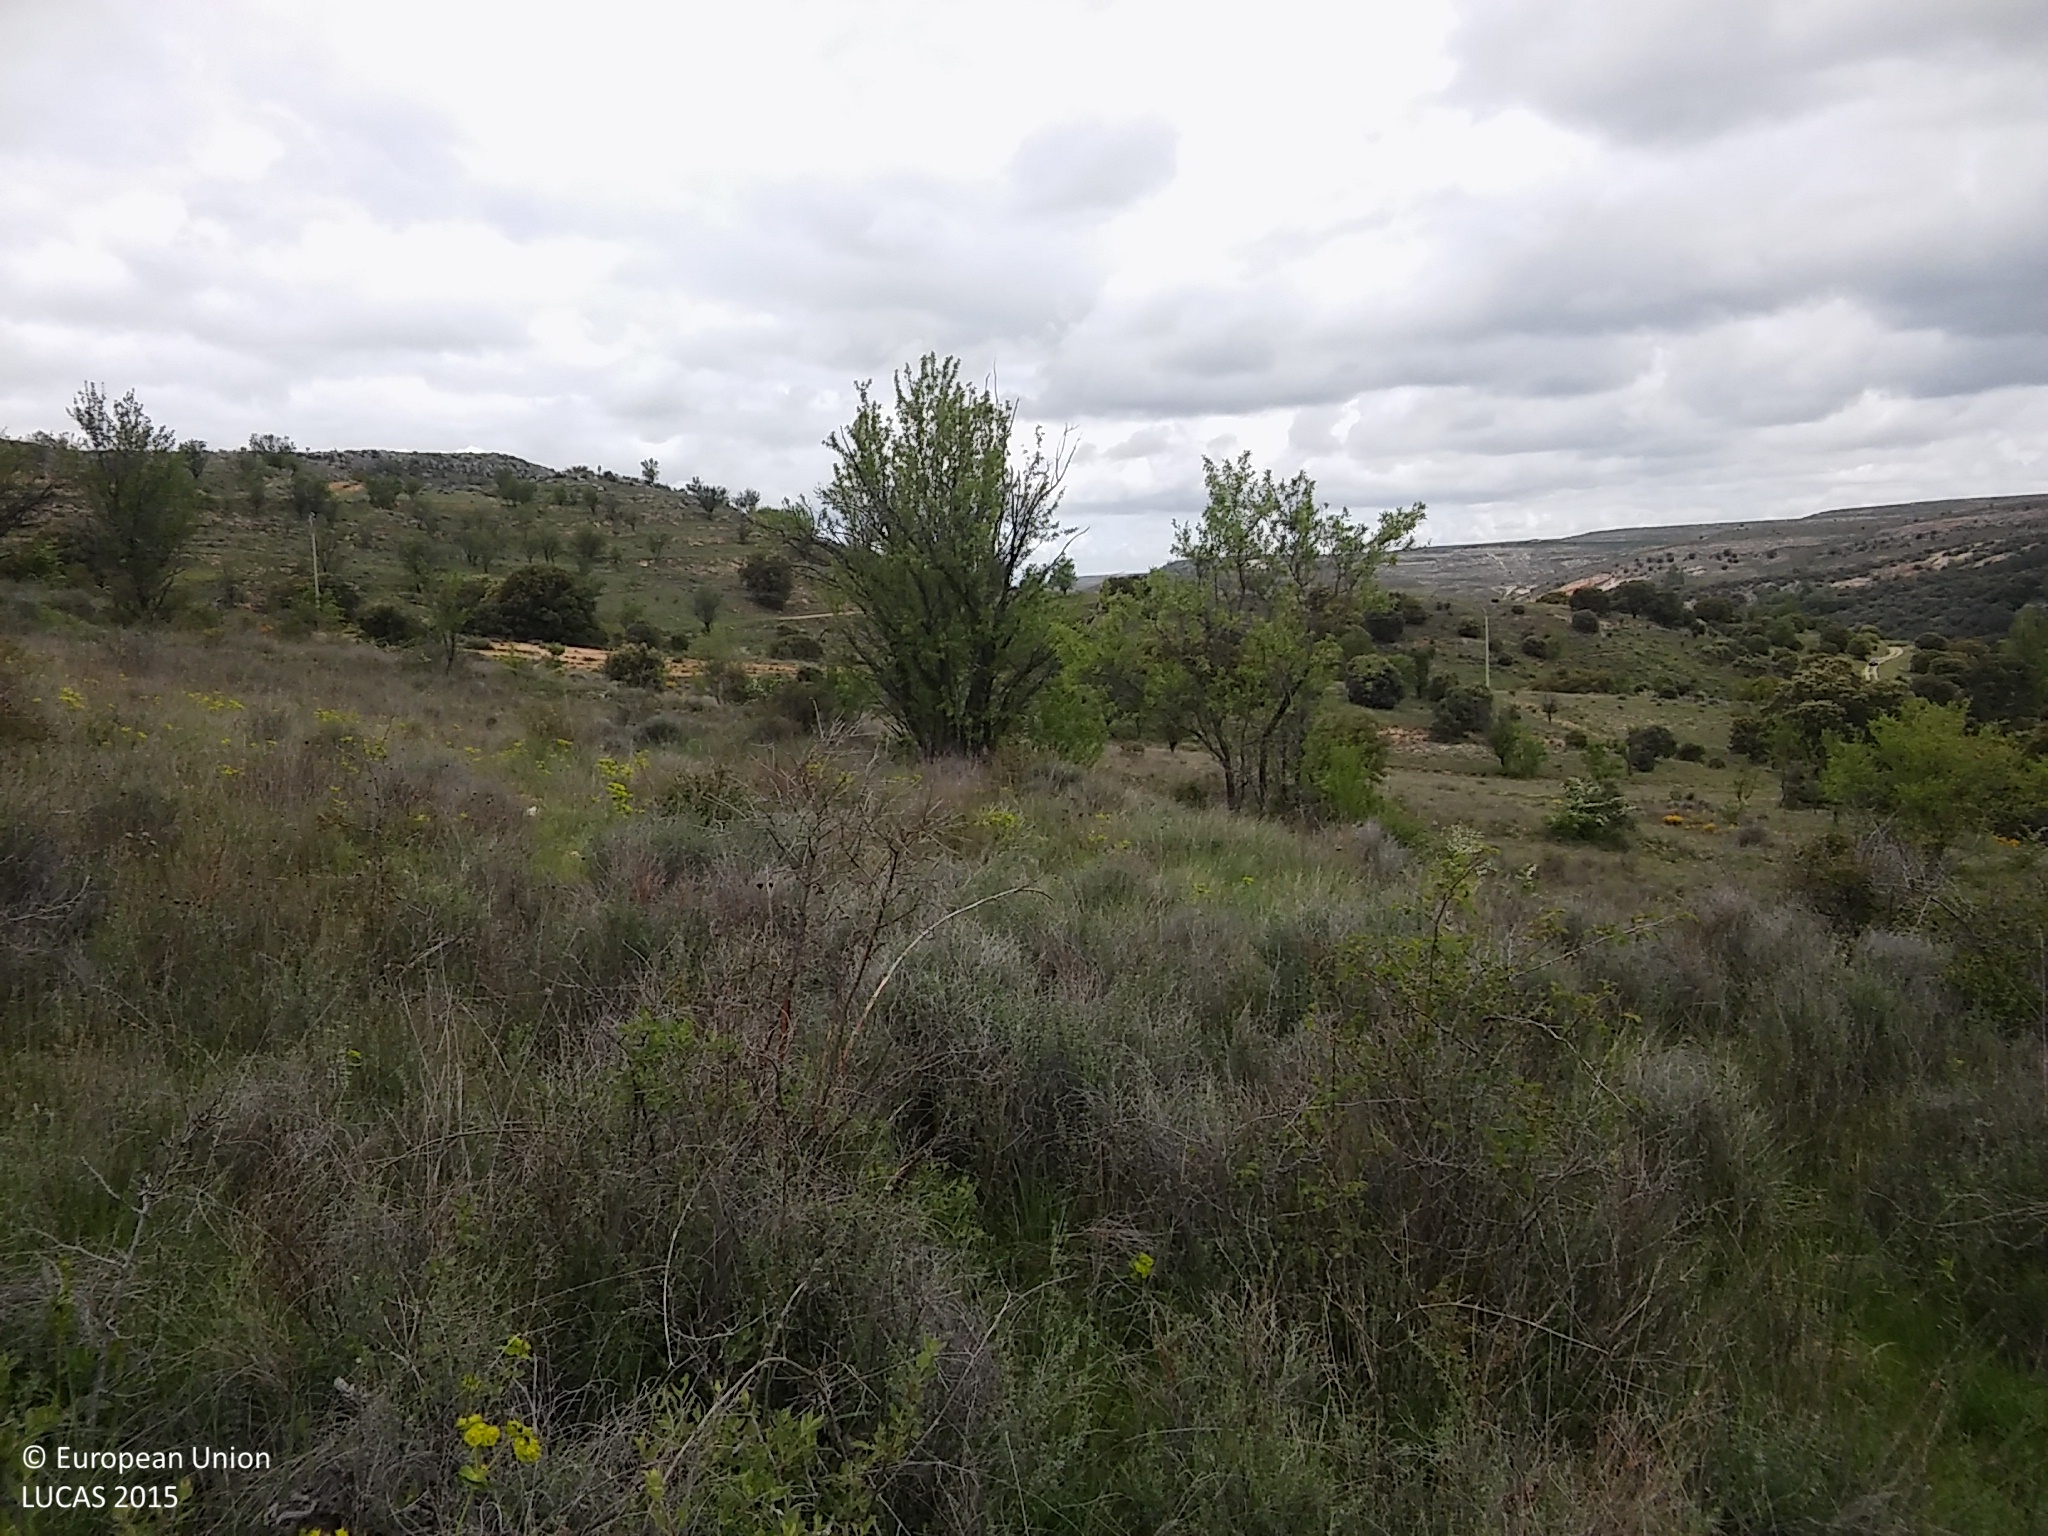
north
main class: Shrubland
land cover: Shrubland with sparse tree cover
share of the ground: 25 - 50 %
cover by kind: herbaceous plants 55 %, shrubs 30 %, unconsolidated bare surface 10 %, broadleaved forest trees 5 %
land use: Semi-natural and natural areas not in use
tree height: > 5 m
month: May
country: ES
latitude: 41.4242
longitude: -3.9699
